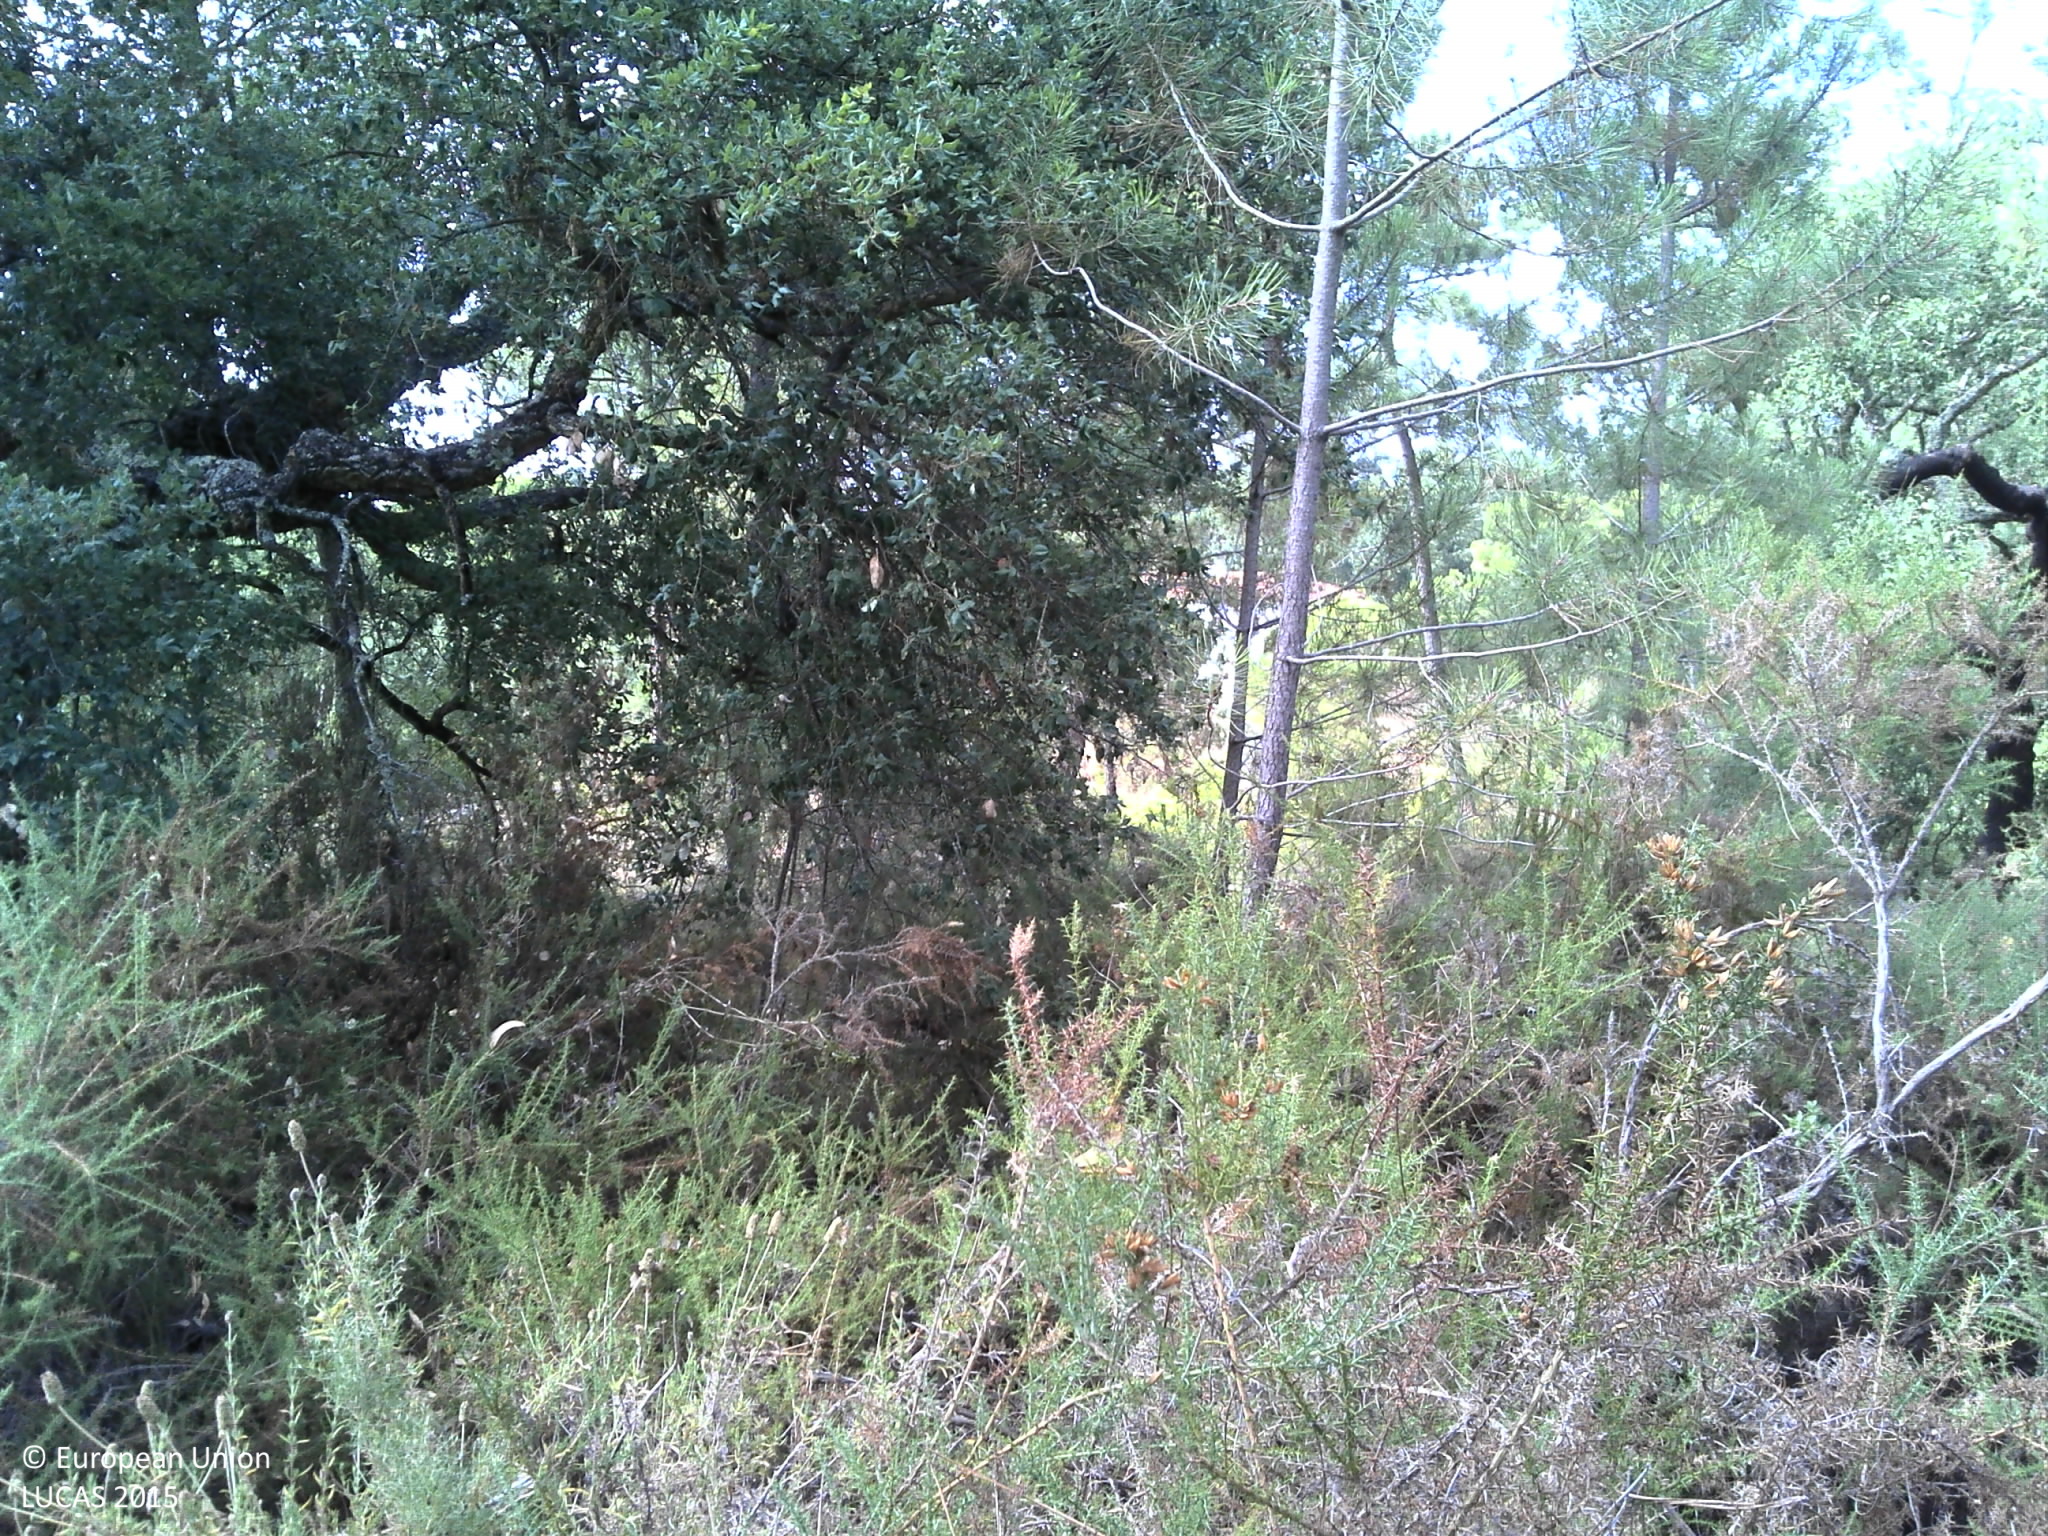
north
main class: Woodland
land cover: Pine dominated mixed woodland
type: coniferous forest of the mediterranean region
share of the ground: 50 - 75 %
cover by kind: coniferous forest trees 35 %, broadleaved forest trees 30 %, shrubs 20 %, unconsolidated bare surface 15 %
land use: Forestry
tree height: > 5 m
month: June
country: PT
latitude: 38.4802
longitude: -9.1098
